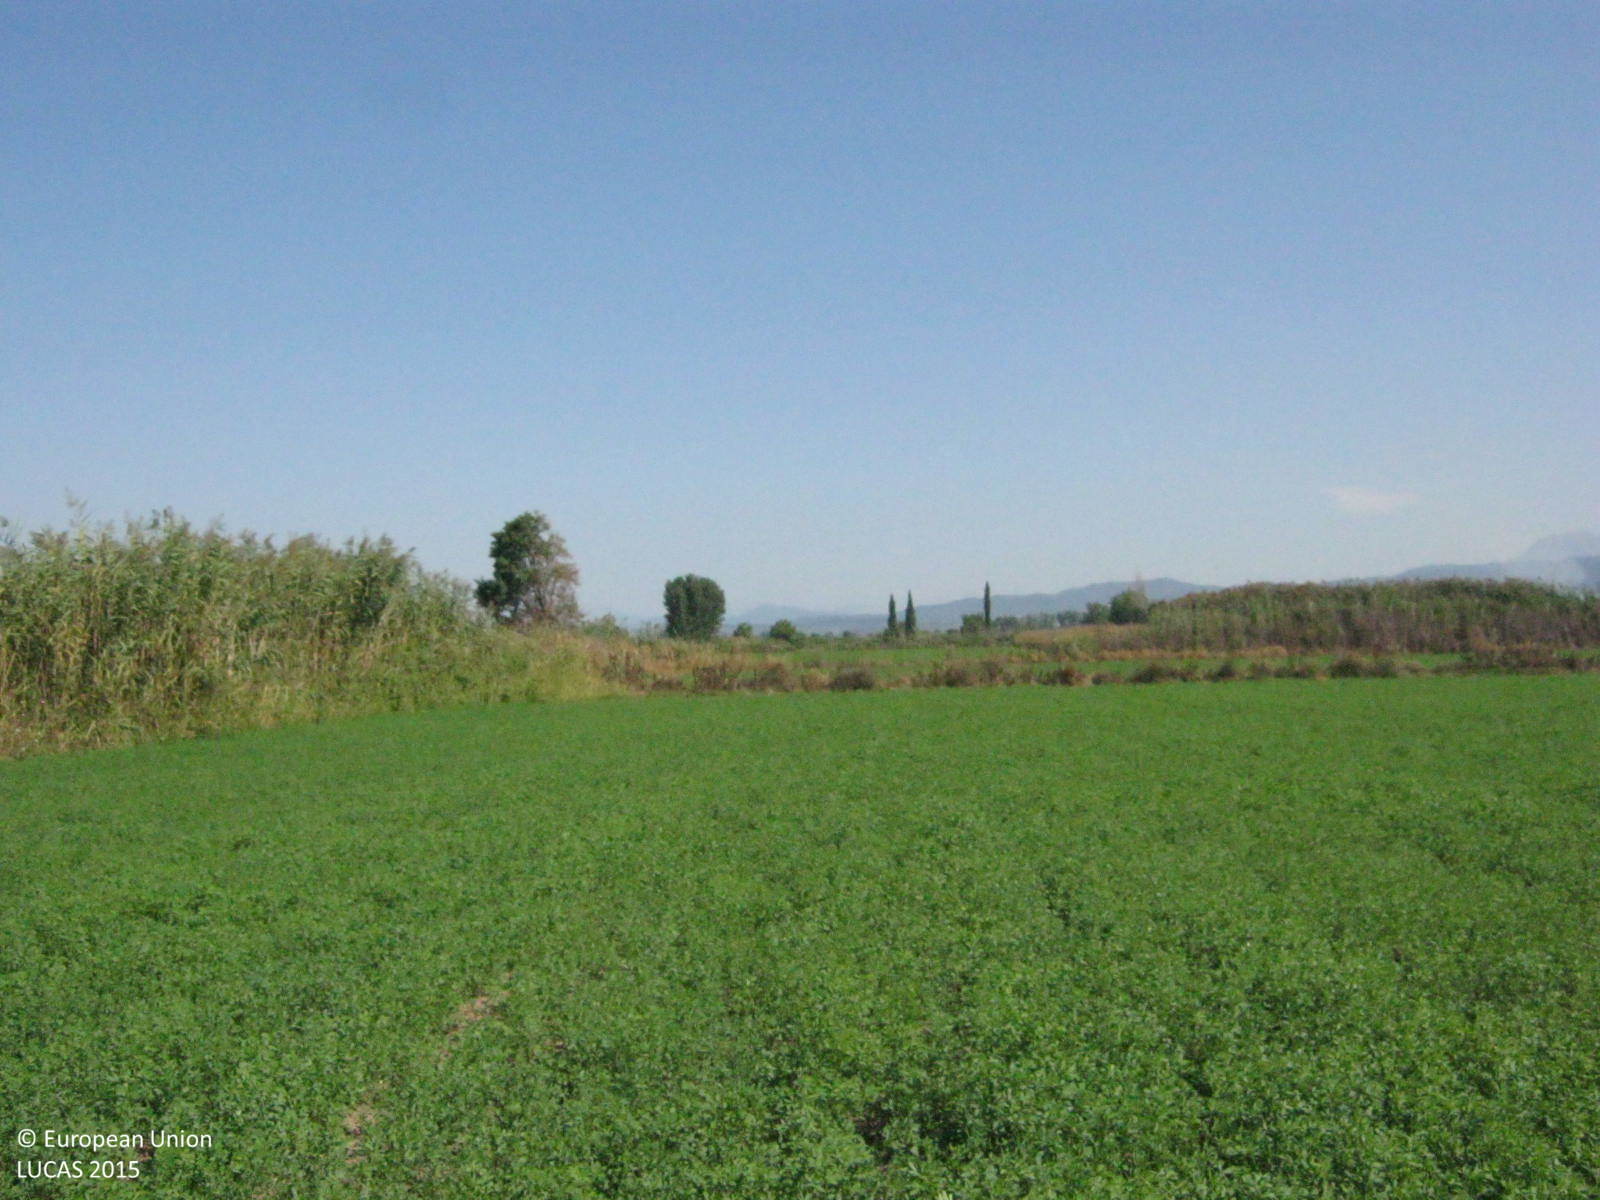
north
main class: Cropland
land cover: Clovers
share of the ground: > 75 %
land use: Agriculture (excluding fallow land and kitchen gardens)
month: September
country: GR
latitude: 38.5868
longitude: 21.3230
